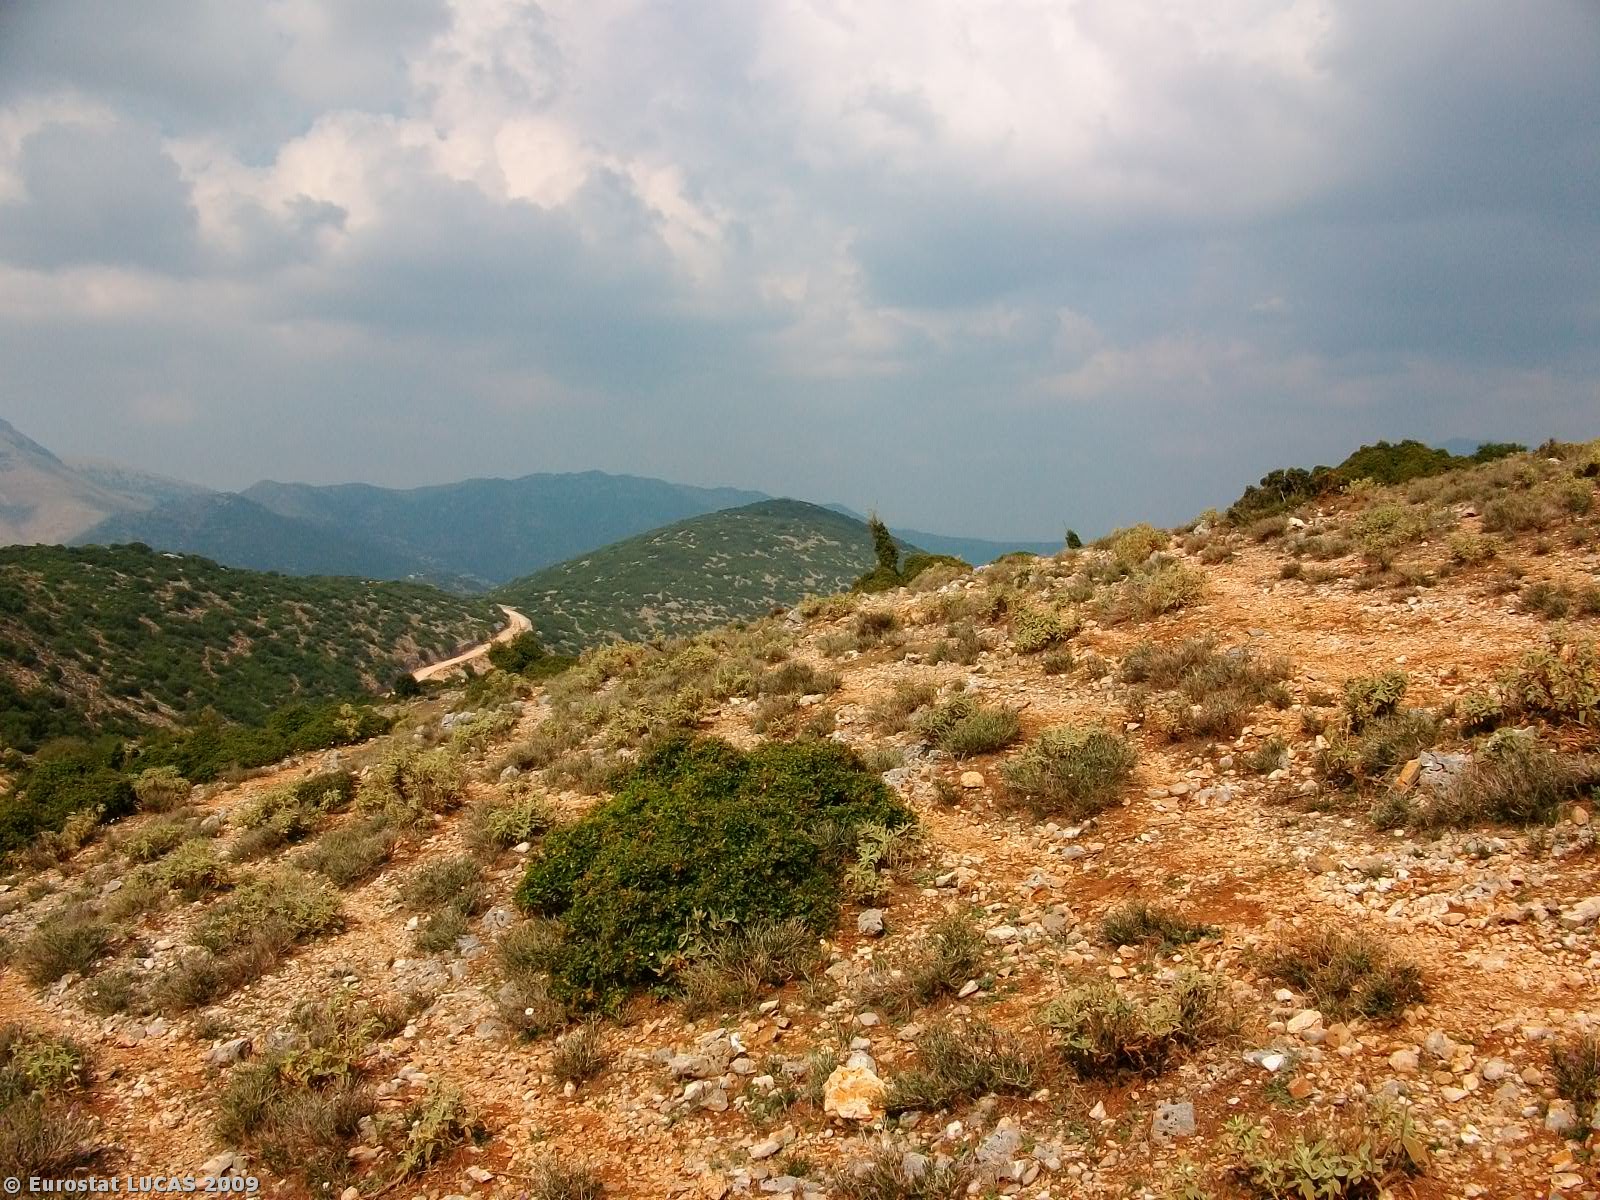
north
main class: Grassland
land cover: Grassland with sparse tree/shrub cover
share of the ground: 25 - 50 %
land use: Agriculture (excluding fallow land and kitchen gardens)
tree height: < 5 m
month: October
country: GR
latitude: 39.4196
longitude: 20.4161
